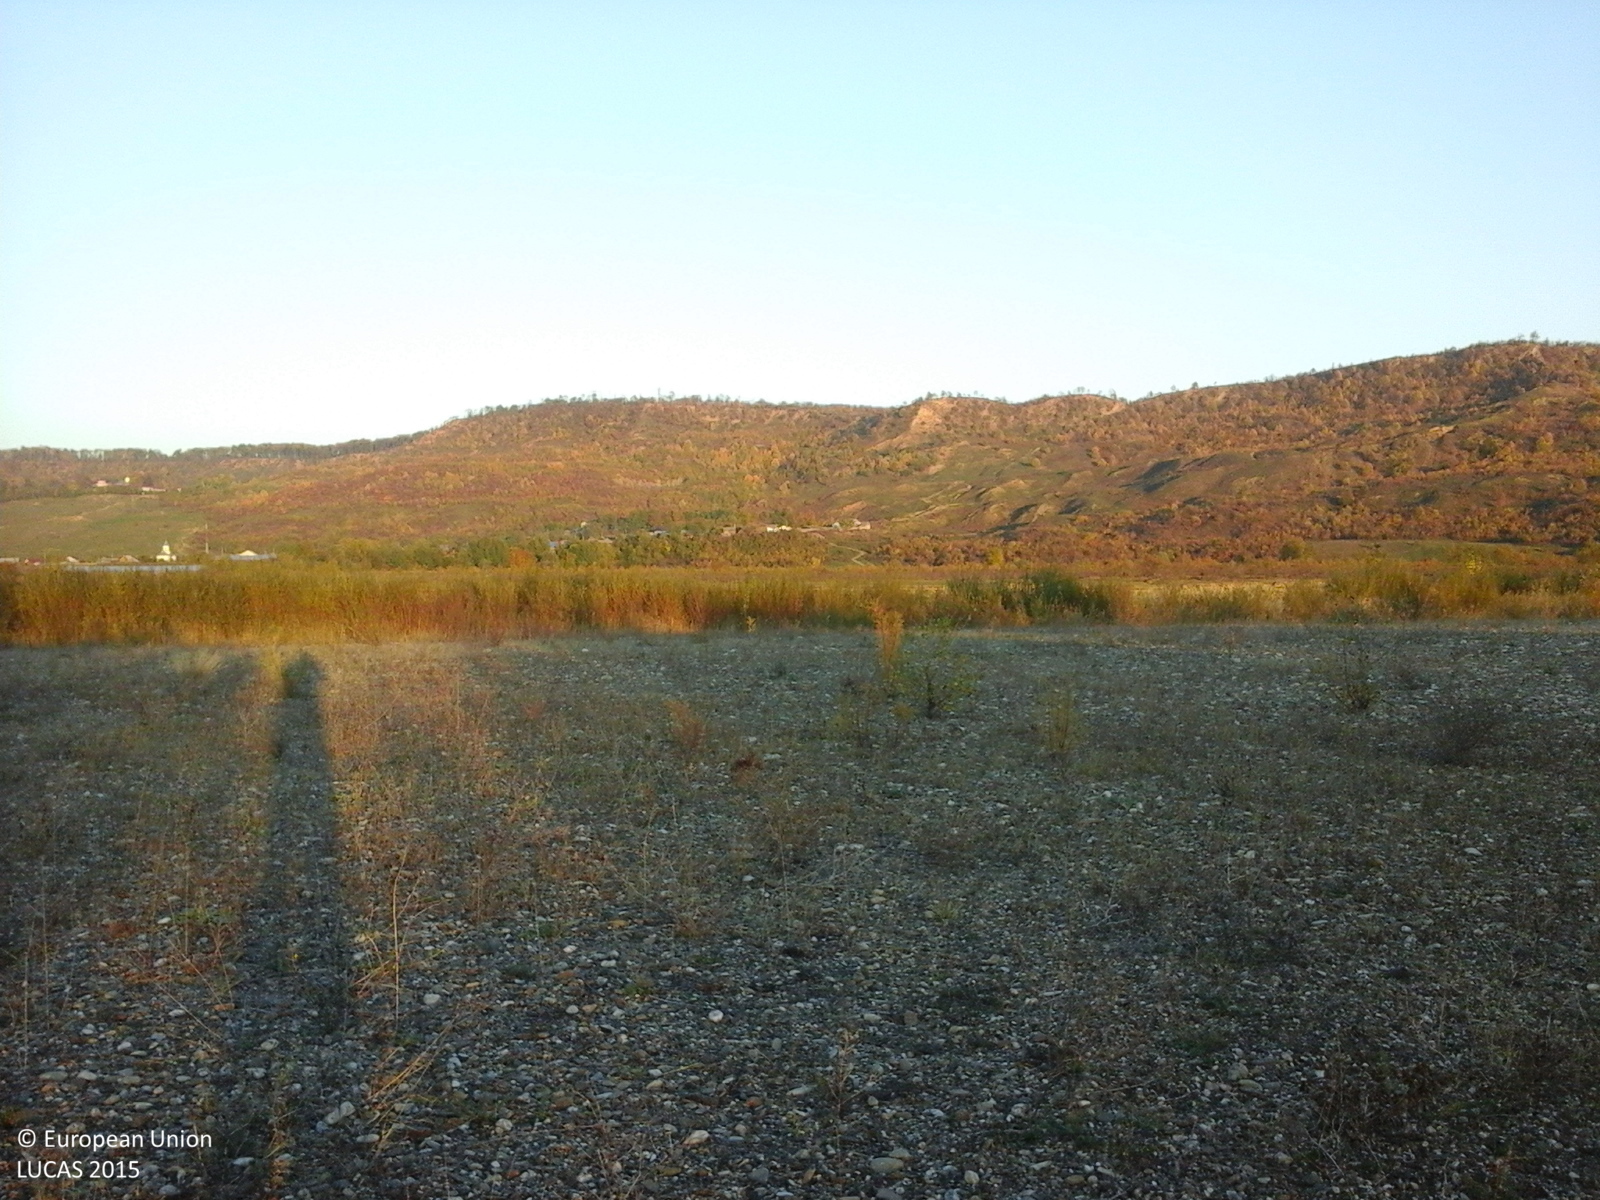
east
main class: Grassland
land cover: Spontaneously vegetated surfaces
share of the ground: 25 - 50 %
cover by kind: consolidated bare surface 75 %, herbaceous plants 25 %
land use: Semi-natural and natural areas not in use
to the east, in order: Spontaneously vegetated surfaces; Shrubland without tree cover; Spontaneously vegetated surfaces; Inland fresh running water; Rocks and stones; Spontaneously vegetated surfaces; Tracks; Spontaneously vegetated surfaces
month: October
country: RO
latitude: 46.0407
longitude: 27.2468
